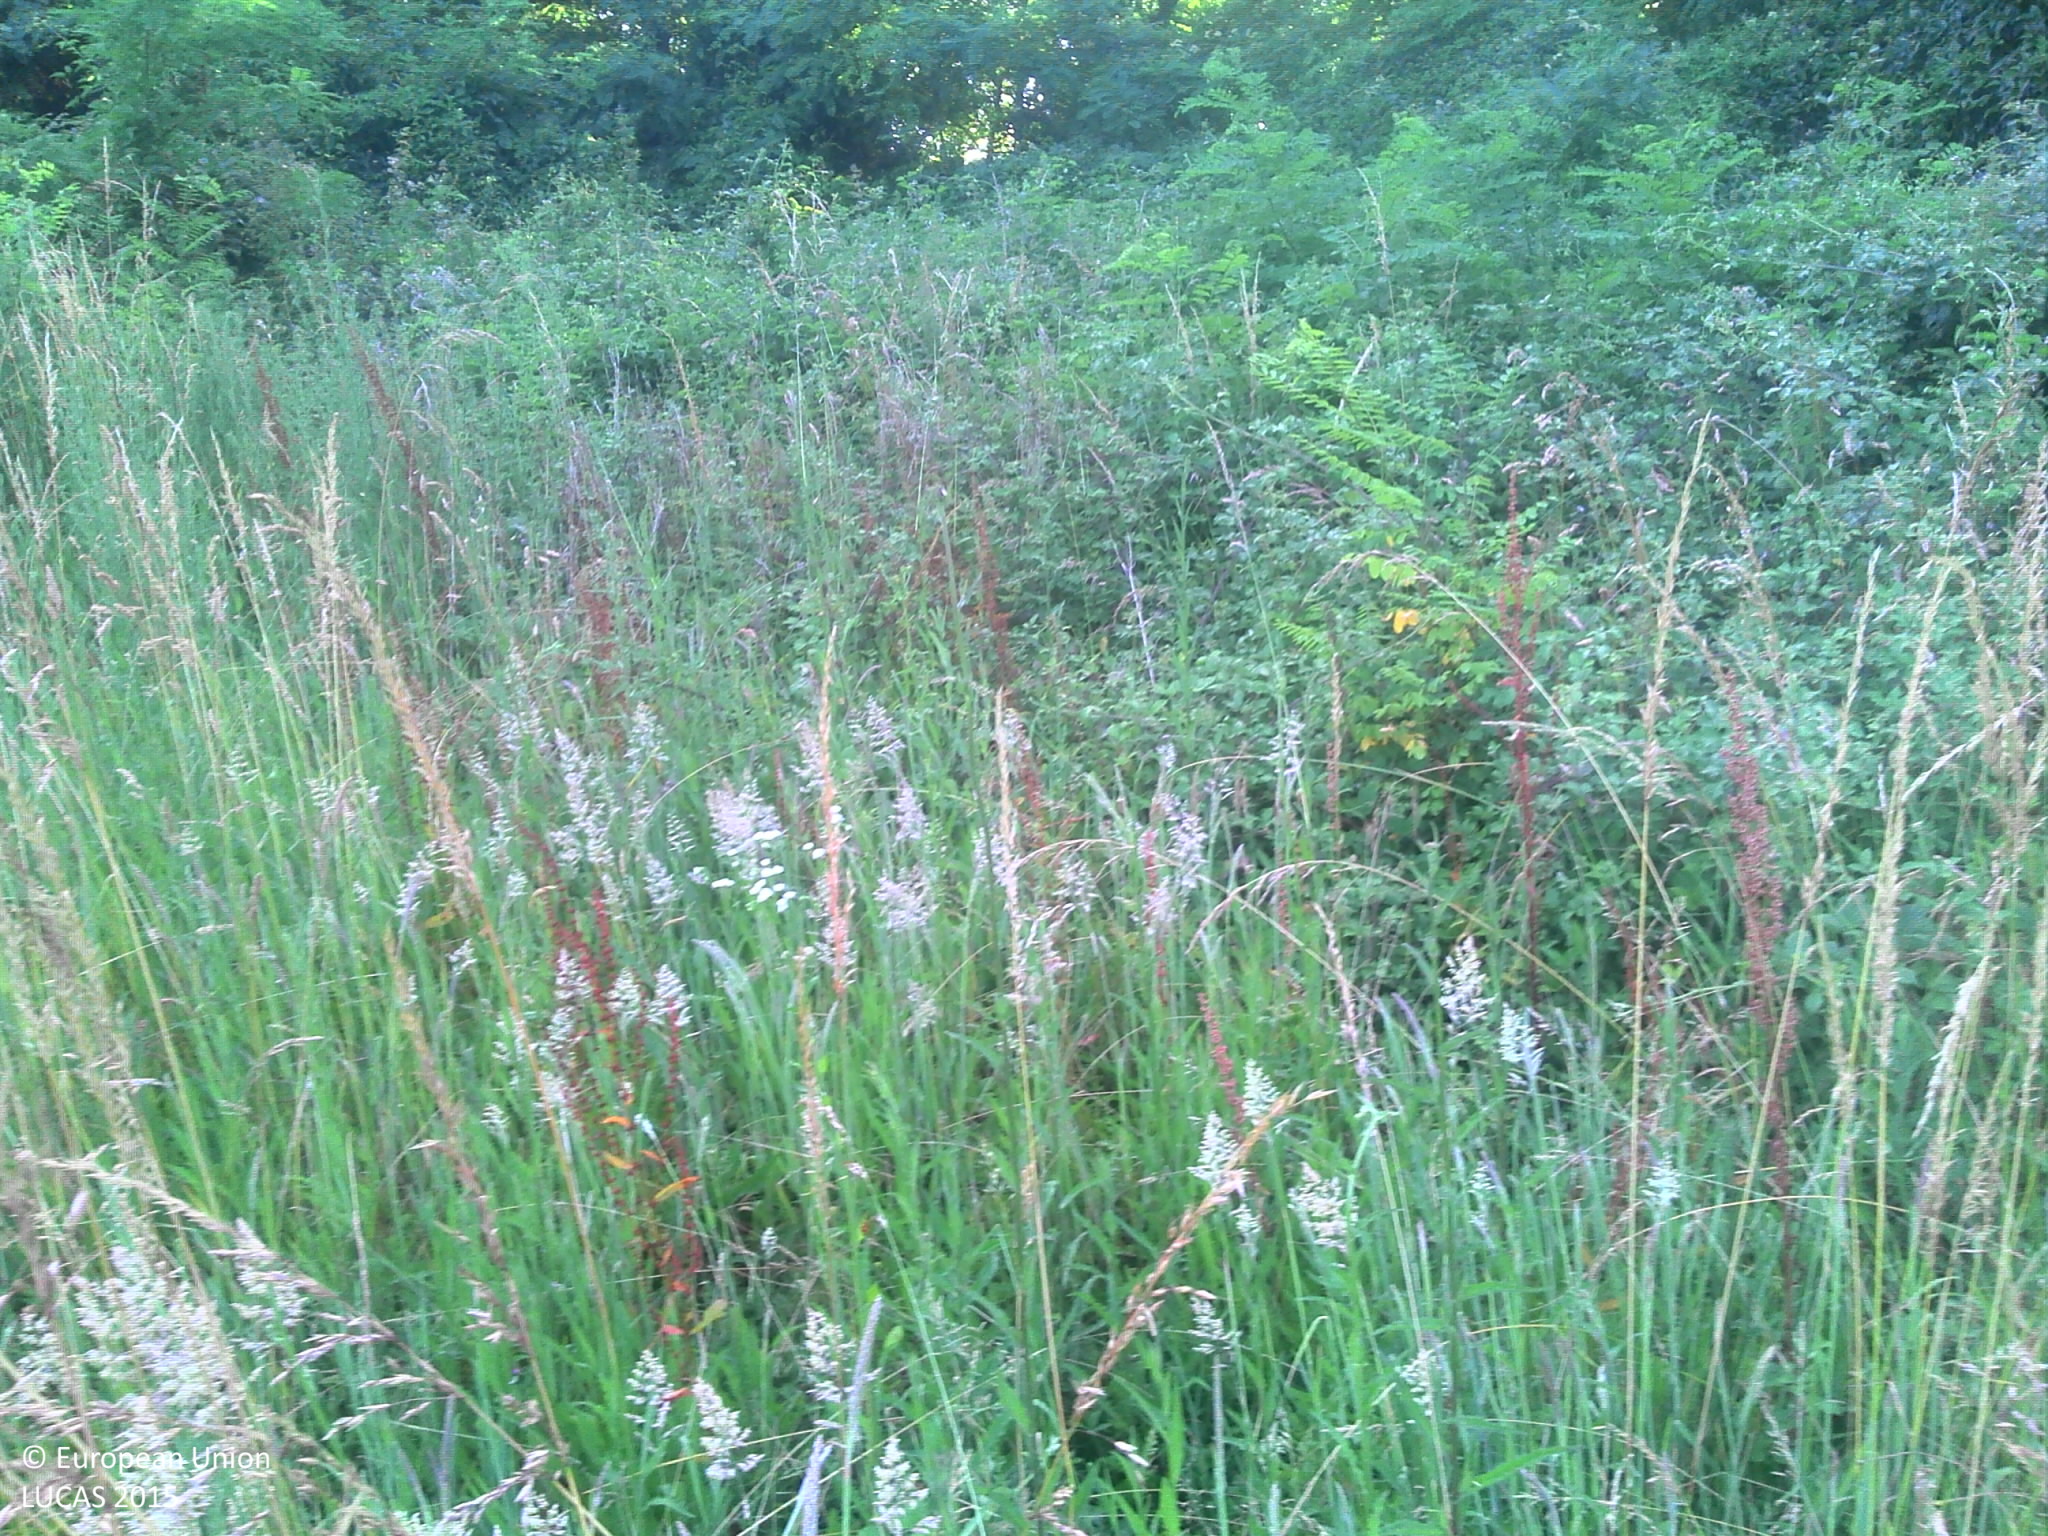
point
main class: Grassland
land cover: Grassland without tree/shrub cover
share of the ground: > 75 %
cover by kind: herbaceous plants 100 %
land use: Agriculture (excluding fallow land and kitchen gardens)
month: June
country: FR
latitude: 47.2386
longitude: 1.4398
